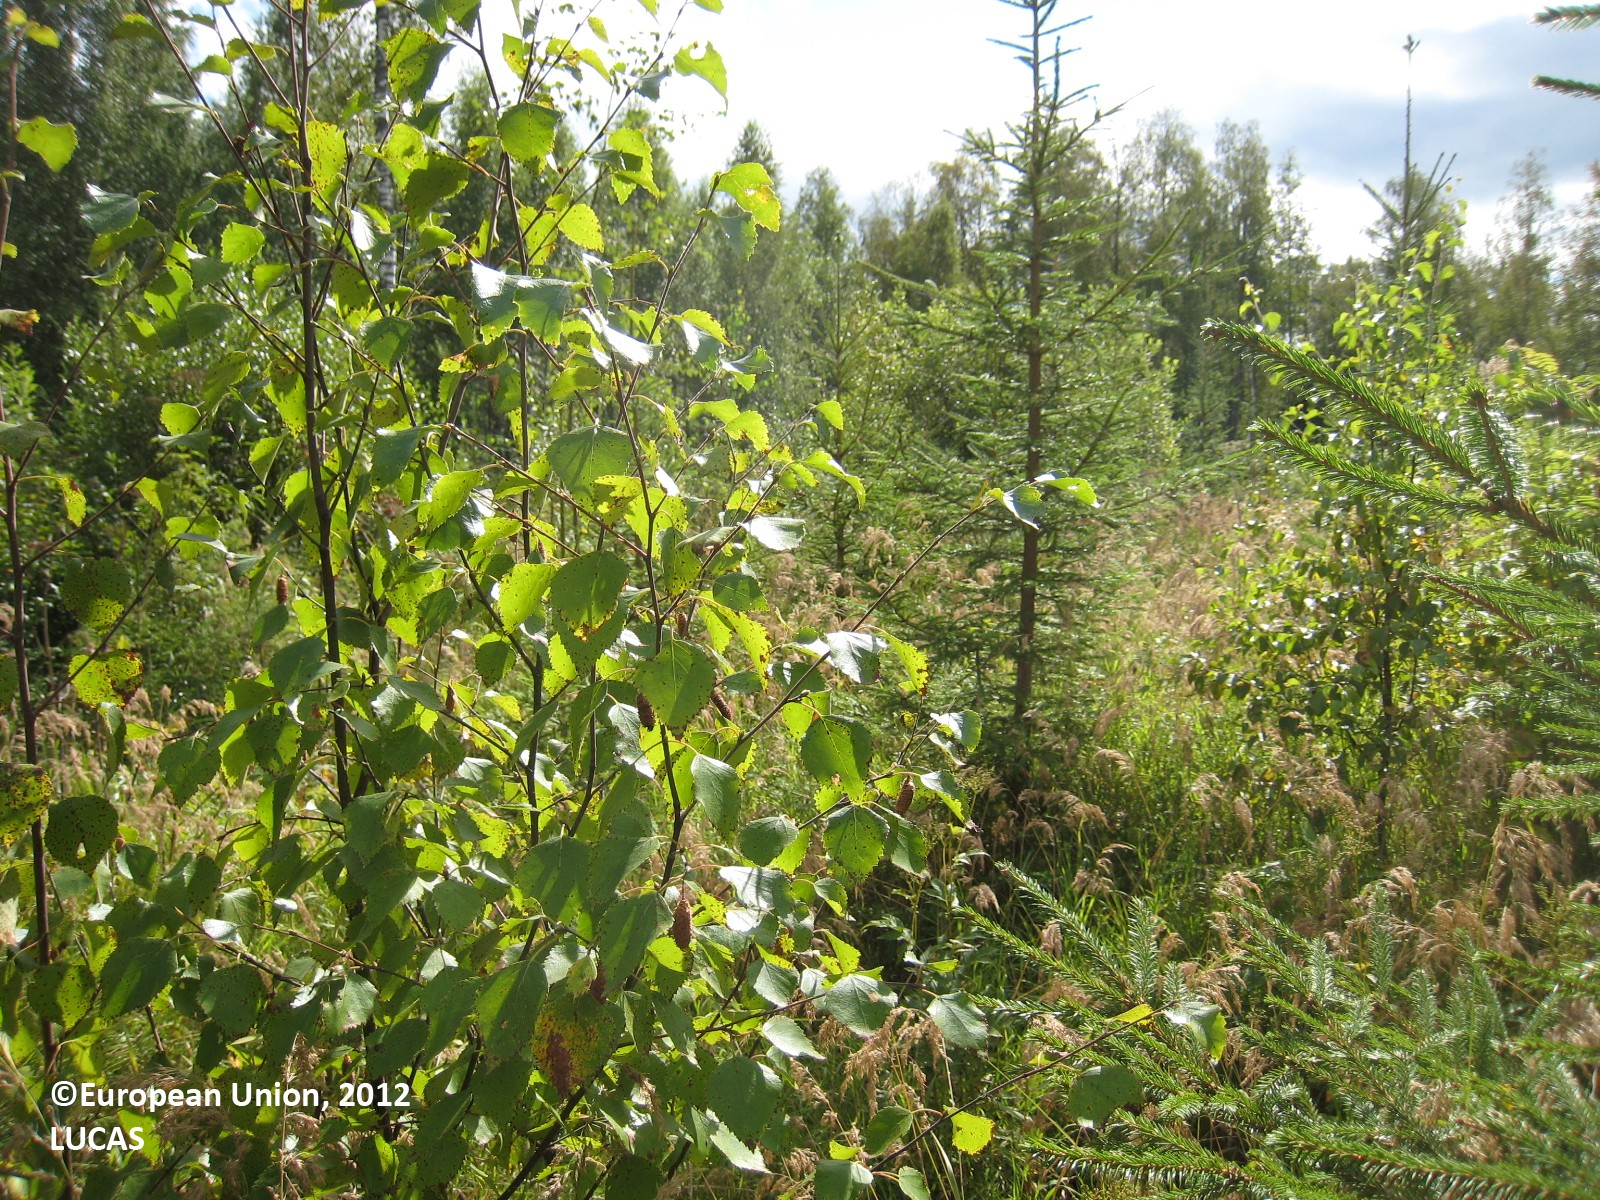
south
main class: Woodland
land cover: Spruce dominated mixed woodland
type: boreal forest
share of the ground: 50 - 75 %
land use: Forestry
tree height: < 5 m
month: August
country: FI
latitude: 61.9807
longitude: 27.2035
